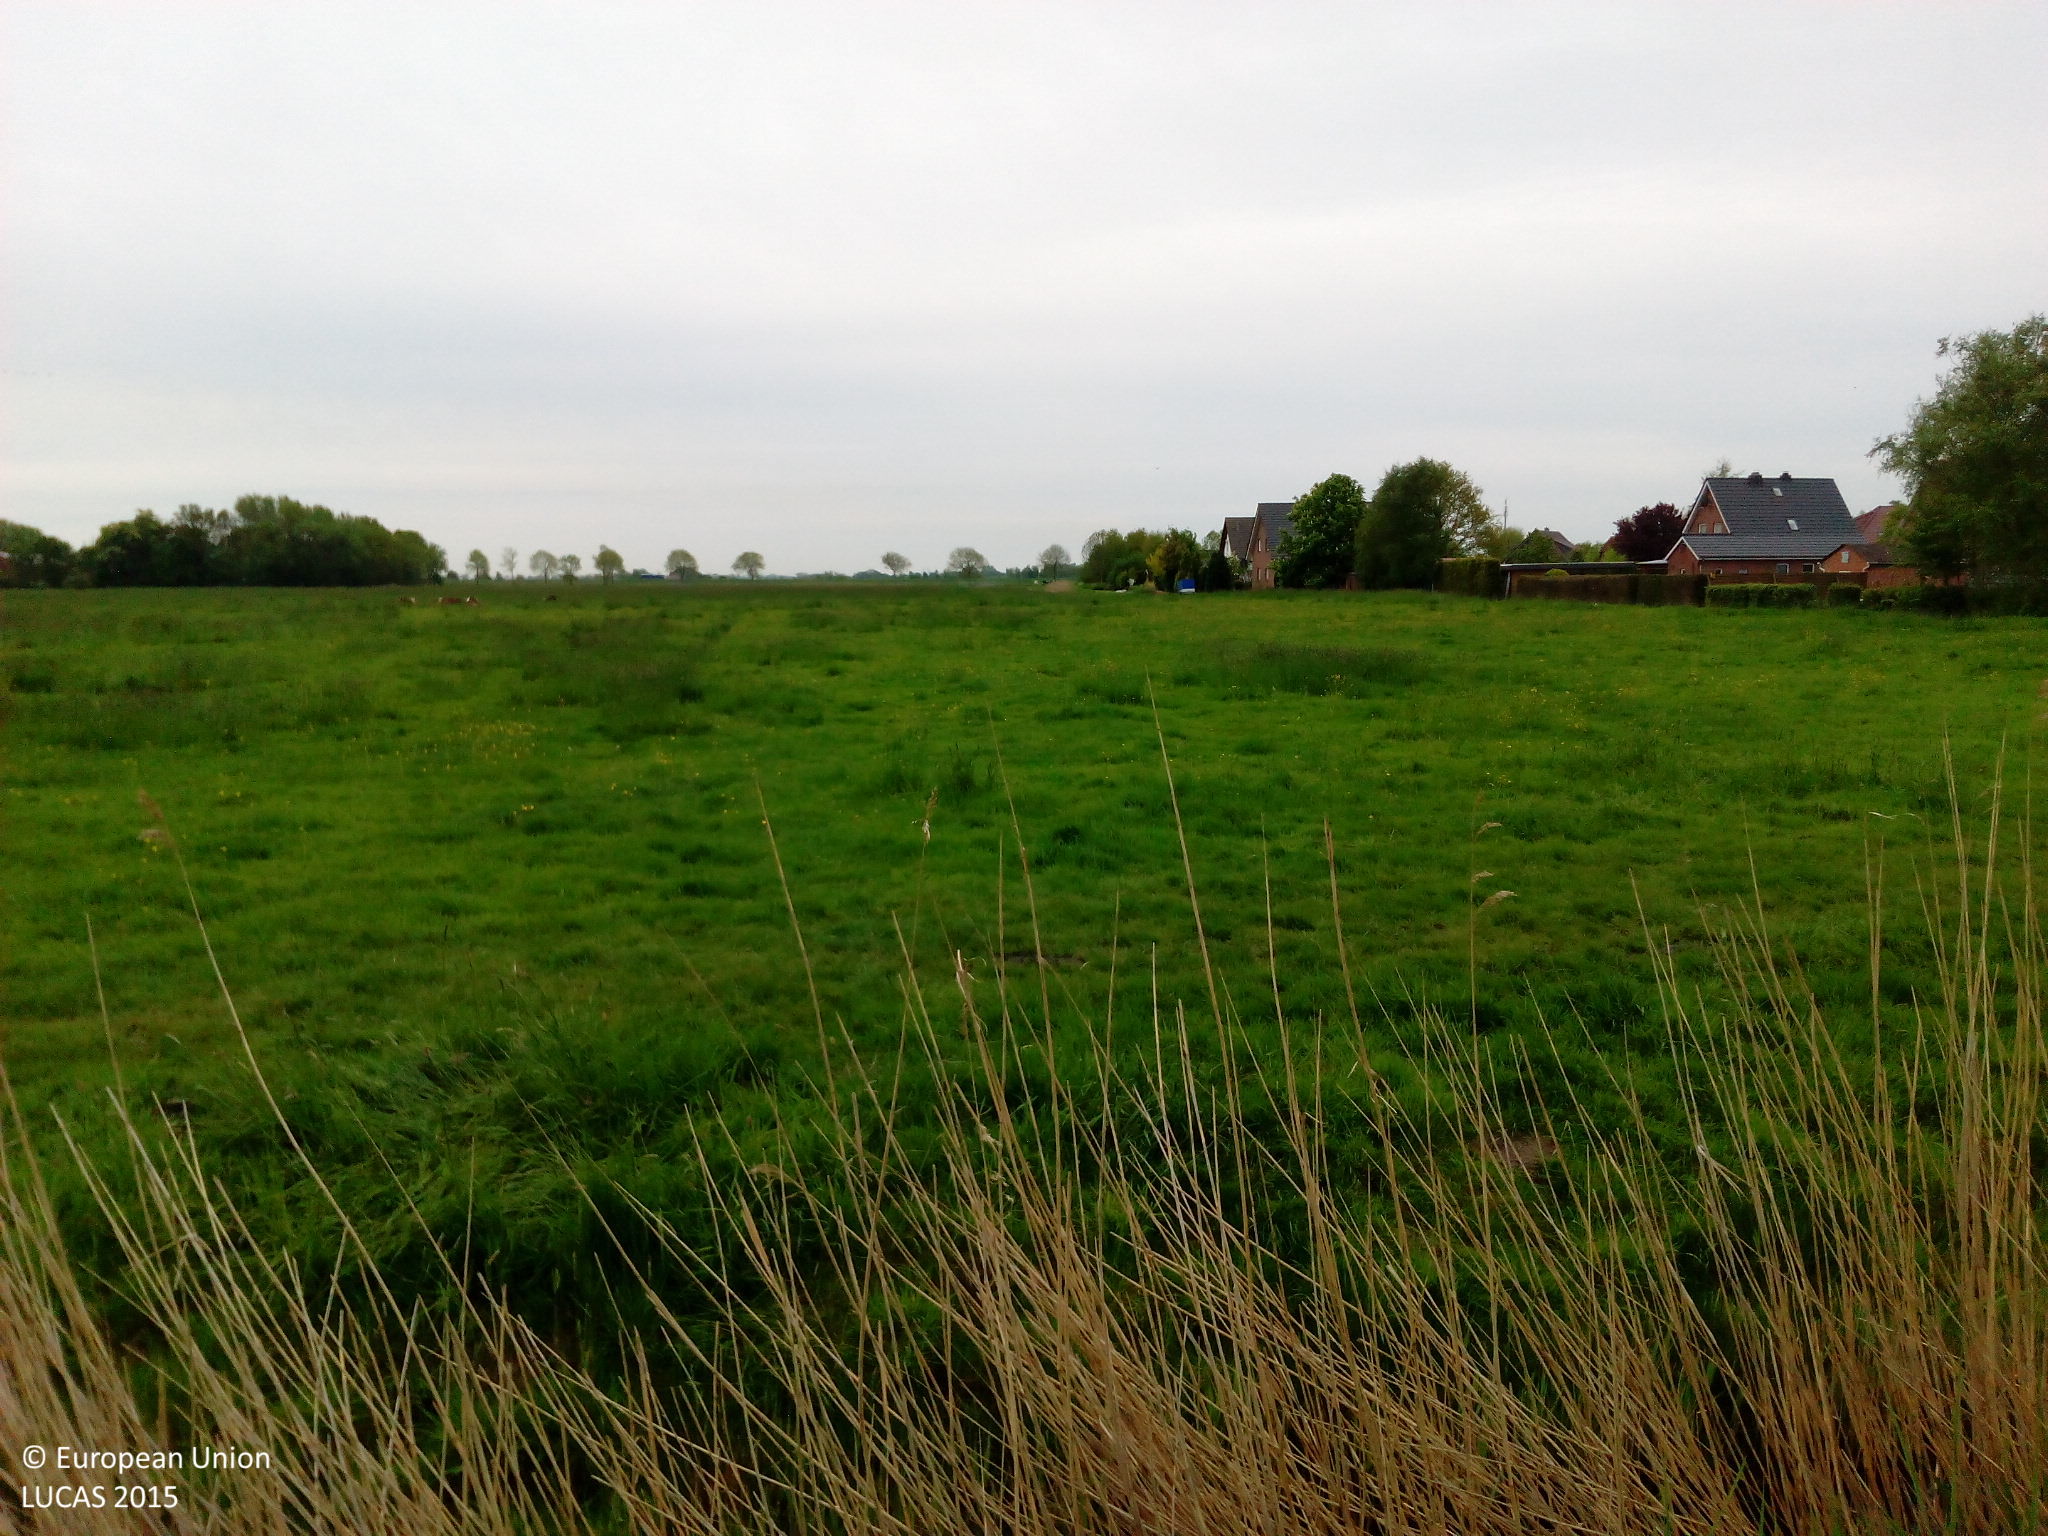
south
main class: Grassland
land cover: Grassland without tree/shrub cover
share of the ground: > 75 %
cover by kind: herbaceous plants 100 %
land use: Agriculture (excluding fallow land and kitchen gardens)
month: May
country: DE
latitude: 53.4467
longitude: 8.5100
